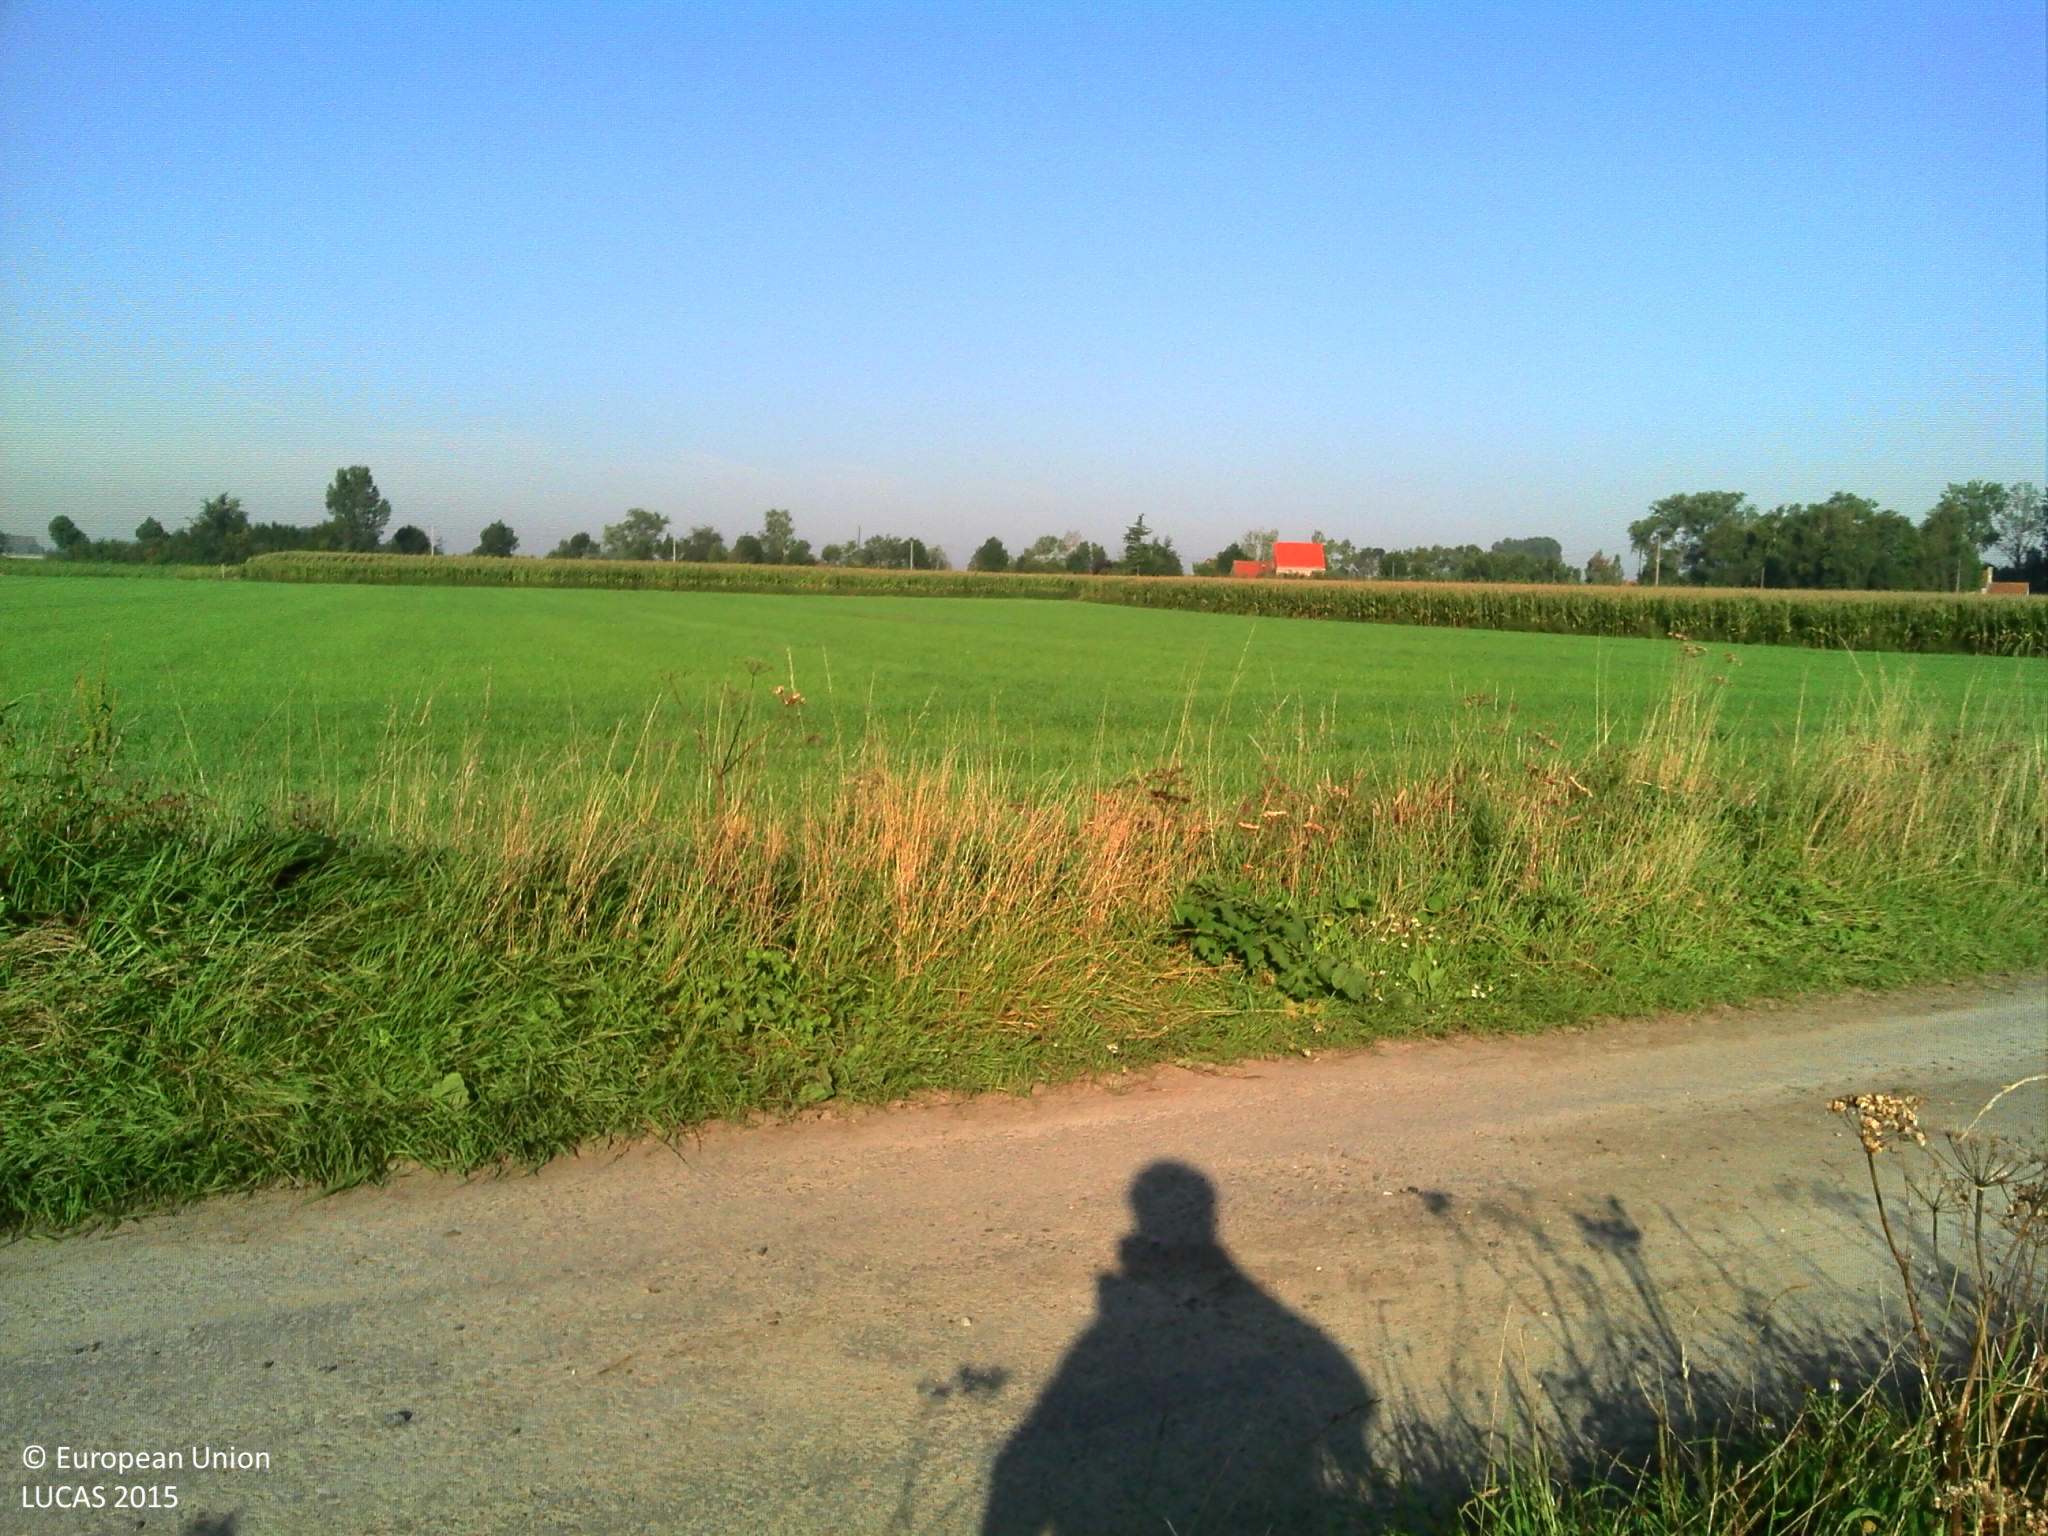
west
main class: Cropland
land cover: Maize
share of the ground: > 75 %
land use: Agriculture (excluding fallow land and kitchen gardens)
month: September
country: BE
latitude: 50.9638
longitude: 2.7411
